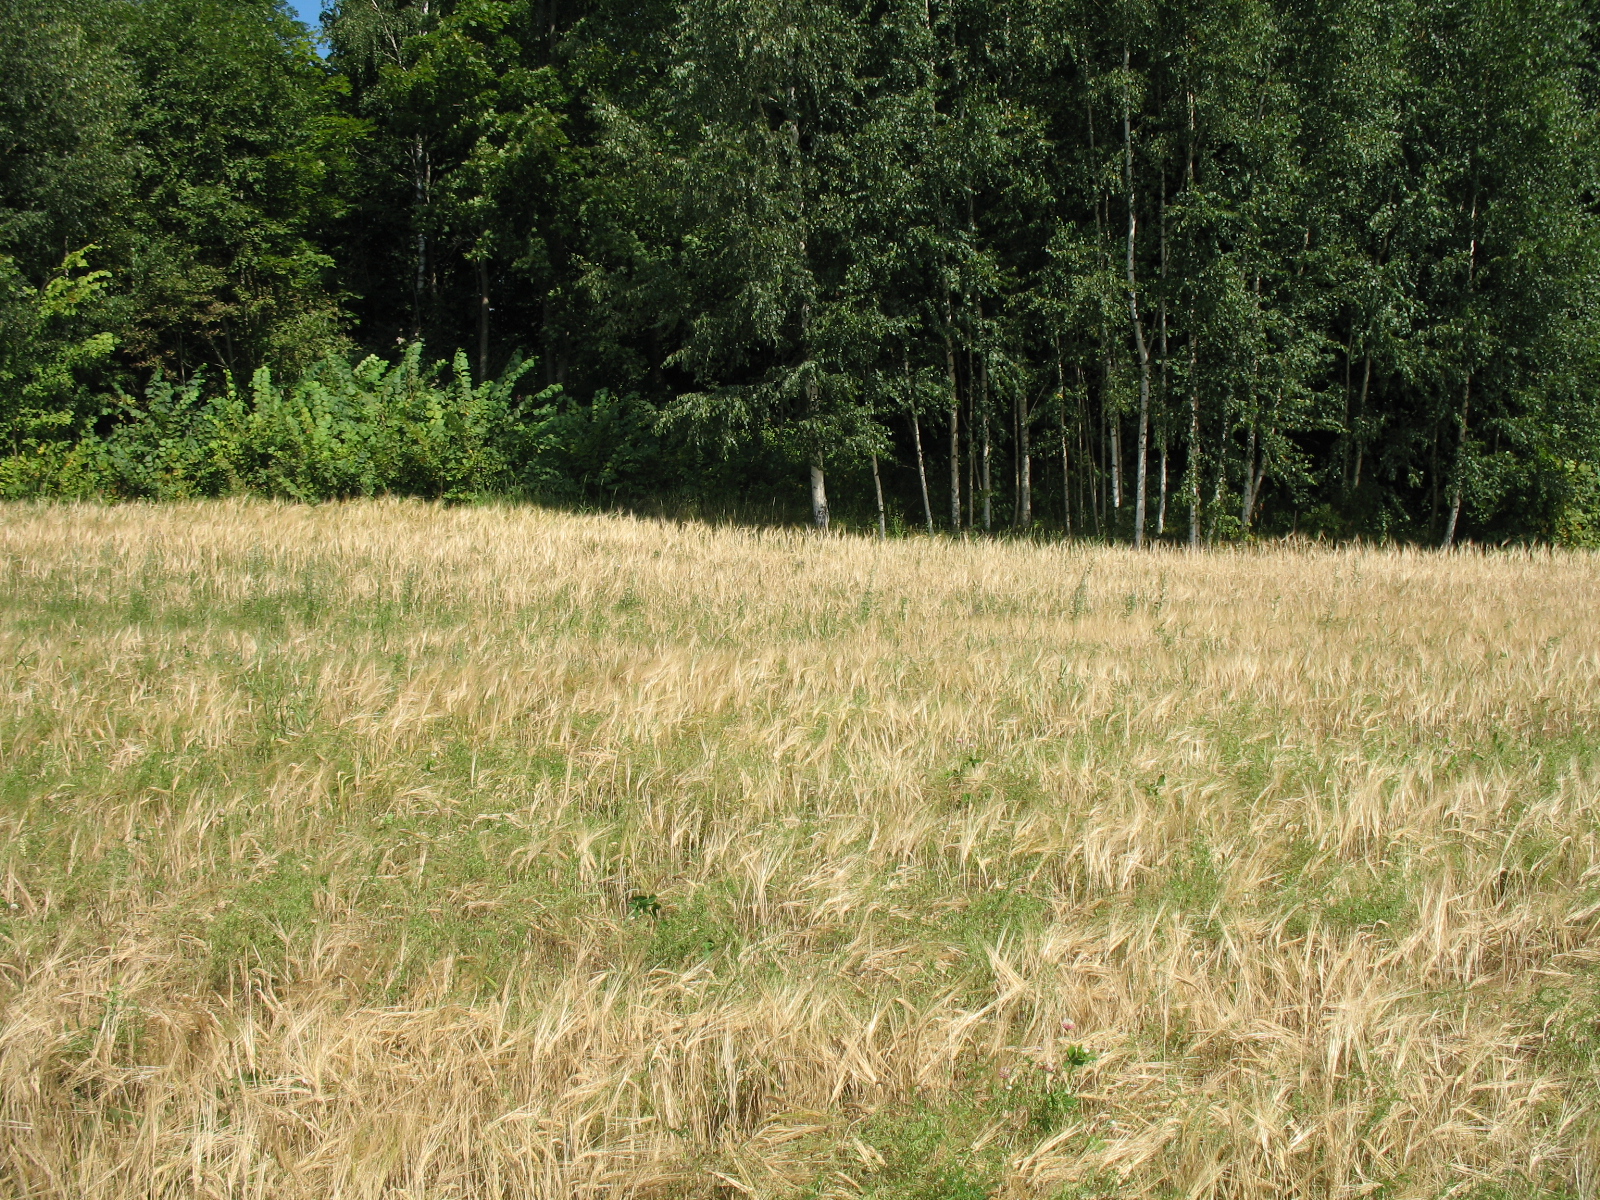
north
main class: Cropland
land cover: Barley
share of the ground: > 75 %
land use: Agriculture (excluding fallow land and kitchen gardens)
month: August
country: LV
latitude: 56.4080
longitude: 25.5334
